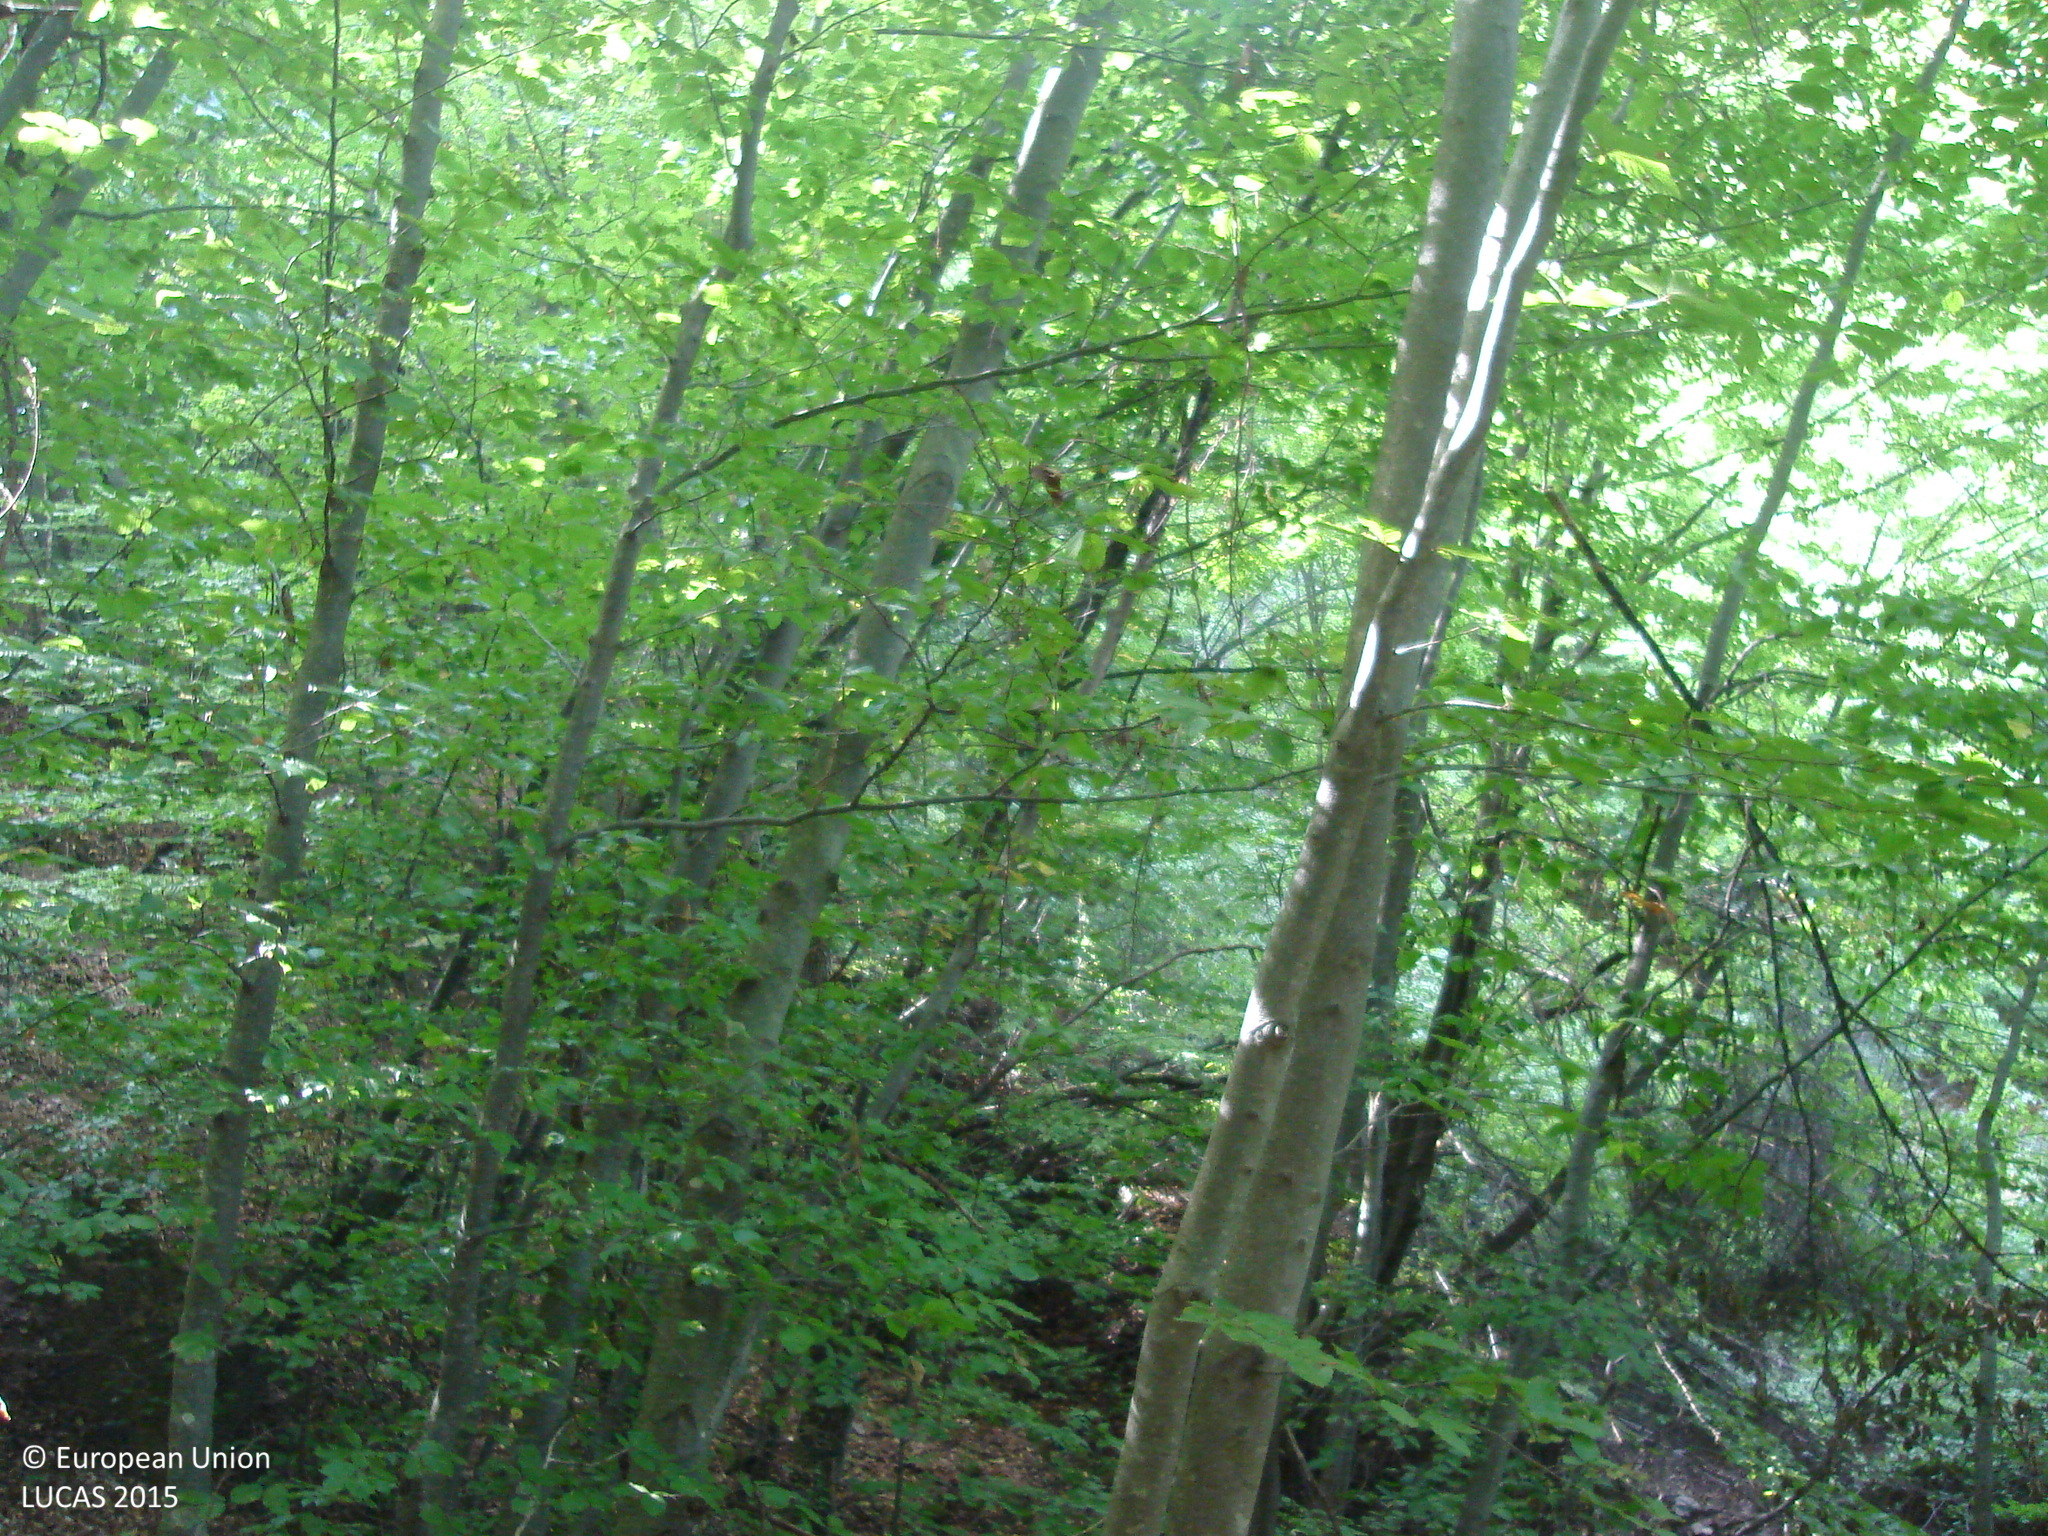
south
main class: Woodland
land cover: Broadleaved woodland
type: beech forest
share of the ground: 50 - 75 %
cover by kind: broadleaved forest trees 70 %, consolidated bare surface 25 %, lichens and mosses 5 %
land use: Forestry
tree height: > 5 m
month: September
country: BG
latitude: 42.9637
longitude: 23.4134
